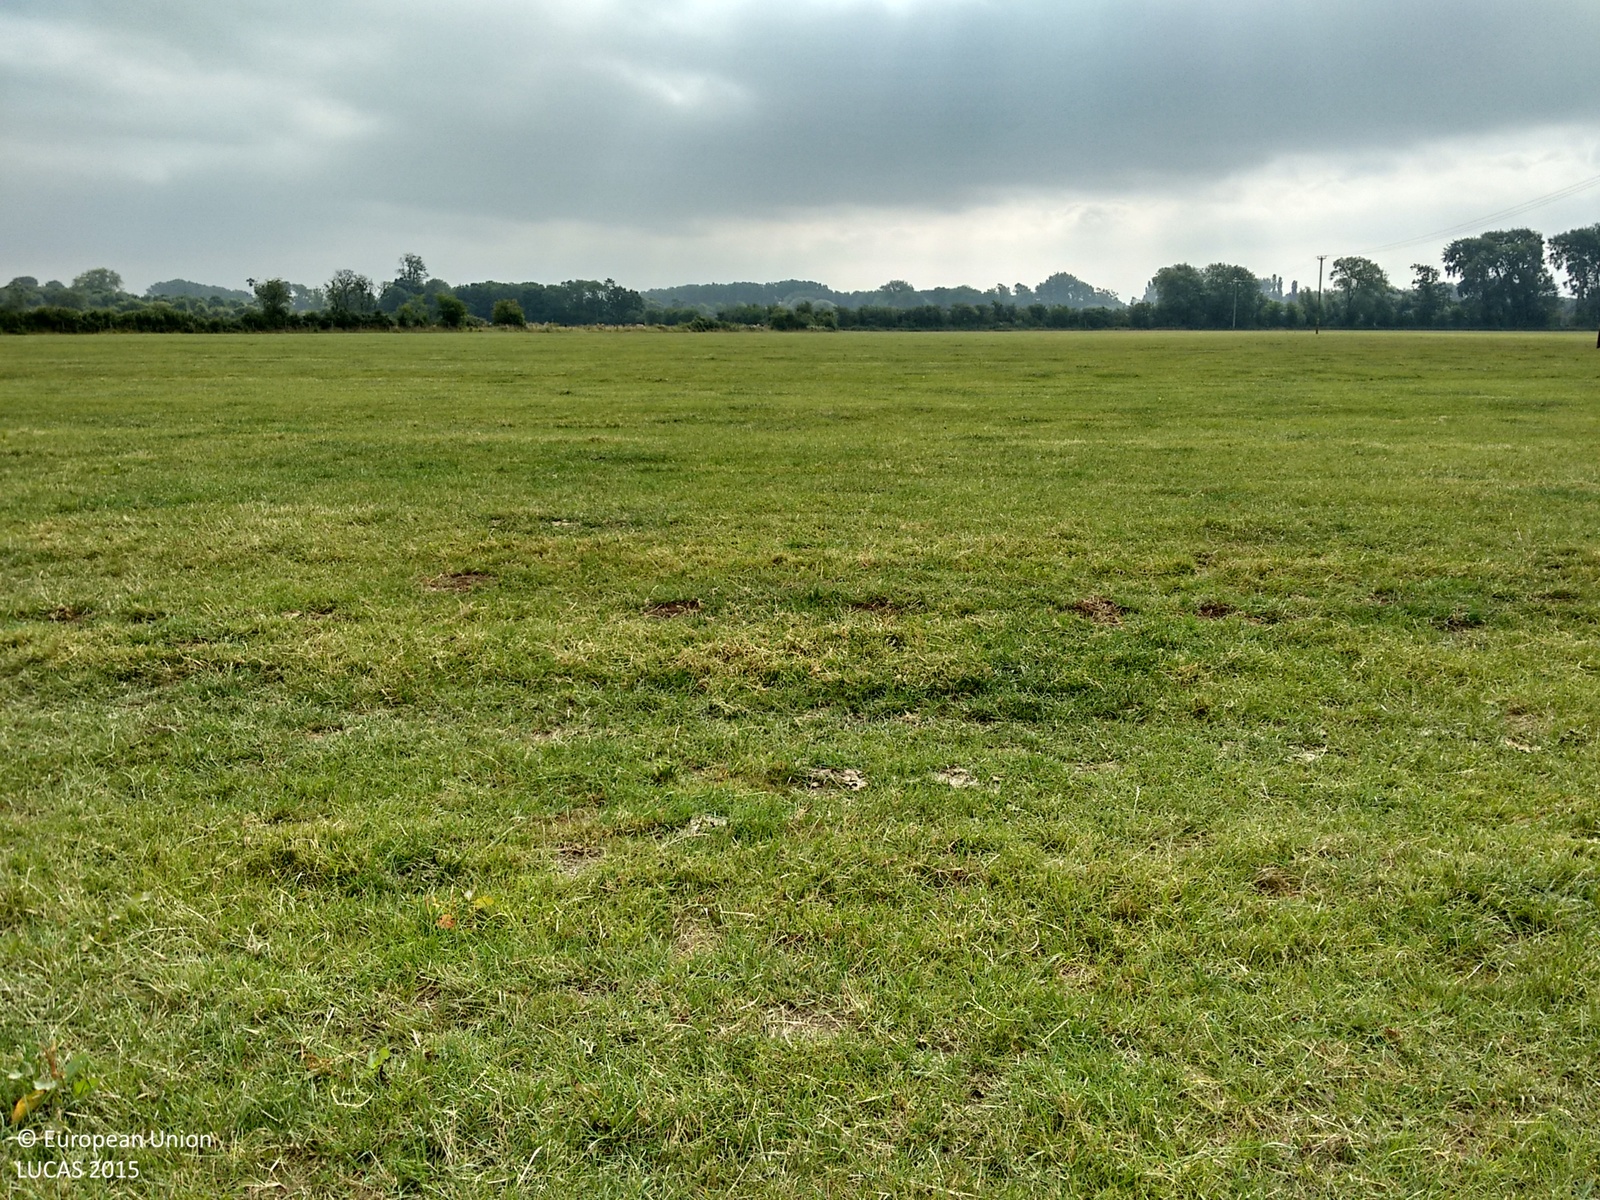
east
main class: Grassland
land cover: Grassland without tree/shrub cover
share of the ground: > 75 %
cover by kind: herbaceous plants 100 %
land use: Agriculture (excluding fallow land and kitchen gardens)
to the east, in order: Grassland without tree/shrub cover; Fences; Abandoned hedges
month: July
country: GB
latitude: 51.7465
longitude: -1.0970
